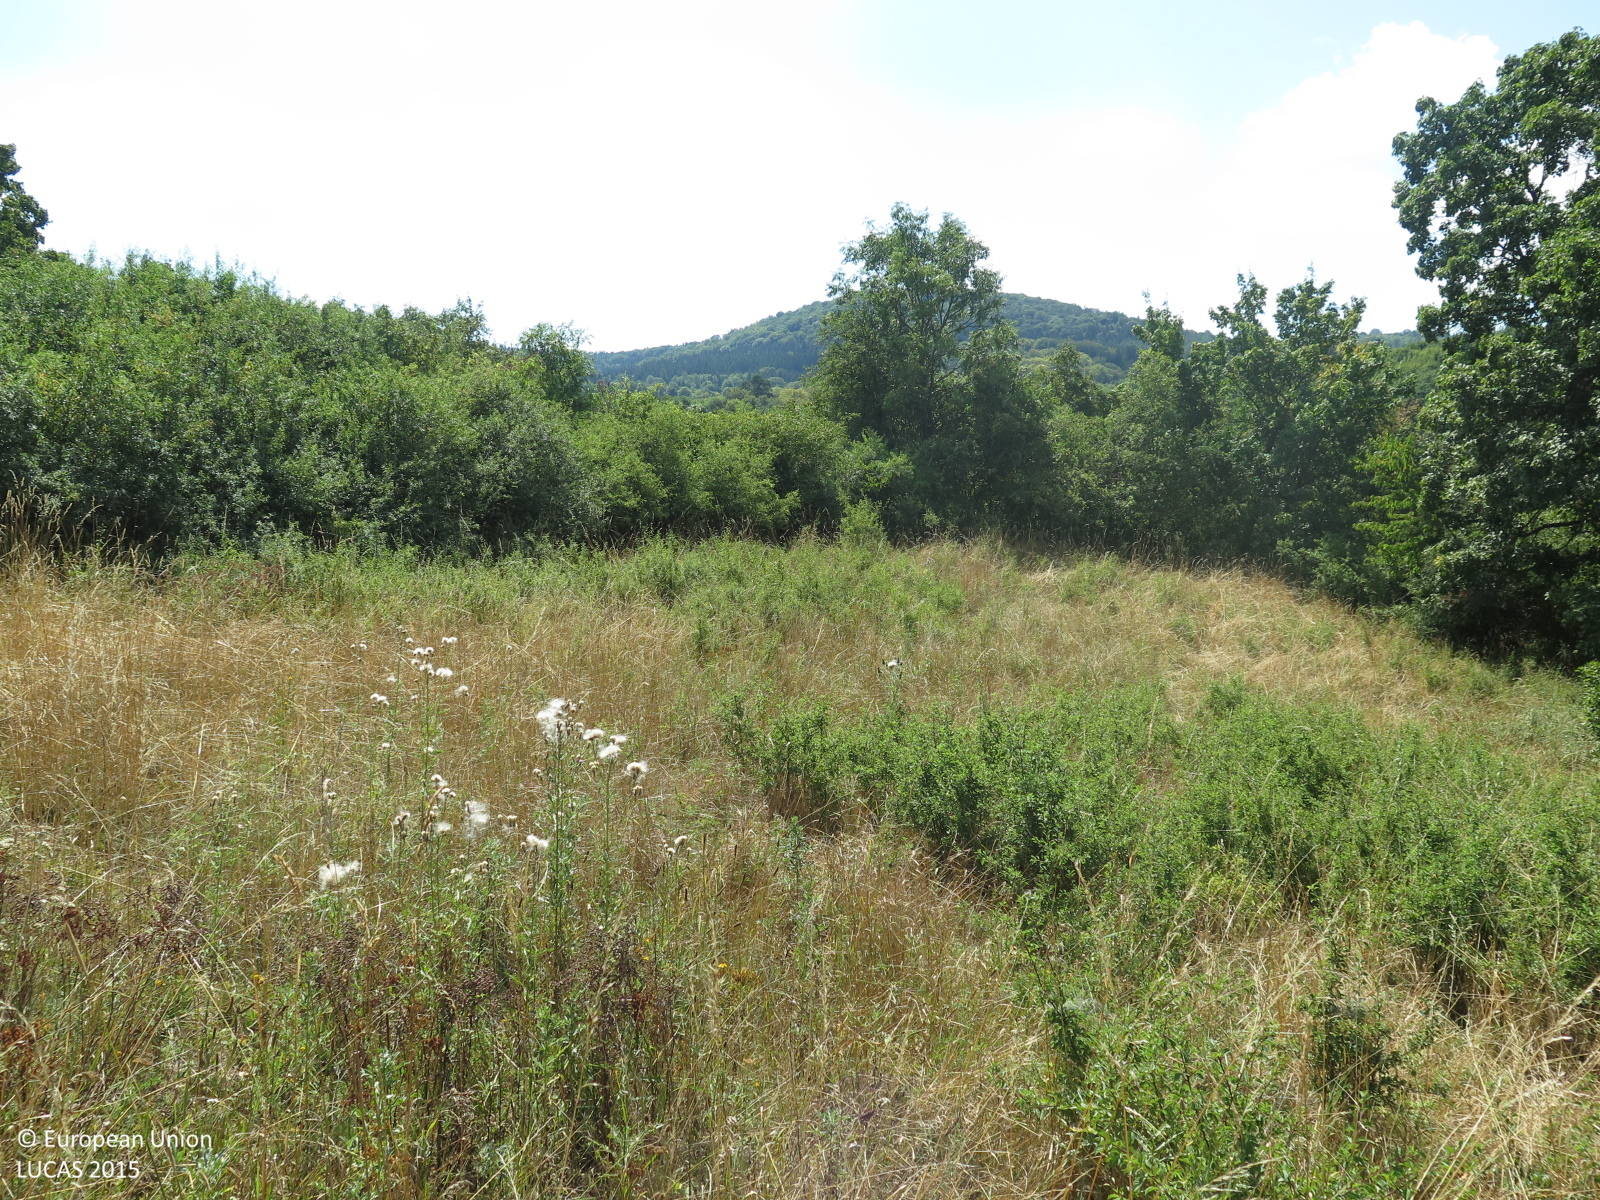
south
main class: Grassland
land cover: Grassland without tree/shrub cover
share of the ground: > 75 %
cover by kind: herbaceous plants 100 %
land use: Agriculture (excluding fallow land and kitchen gardens)
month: August
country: CZ
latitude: 50.0117
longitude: 13.8382
